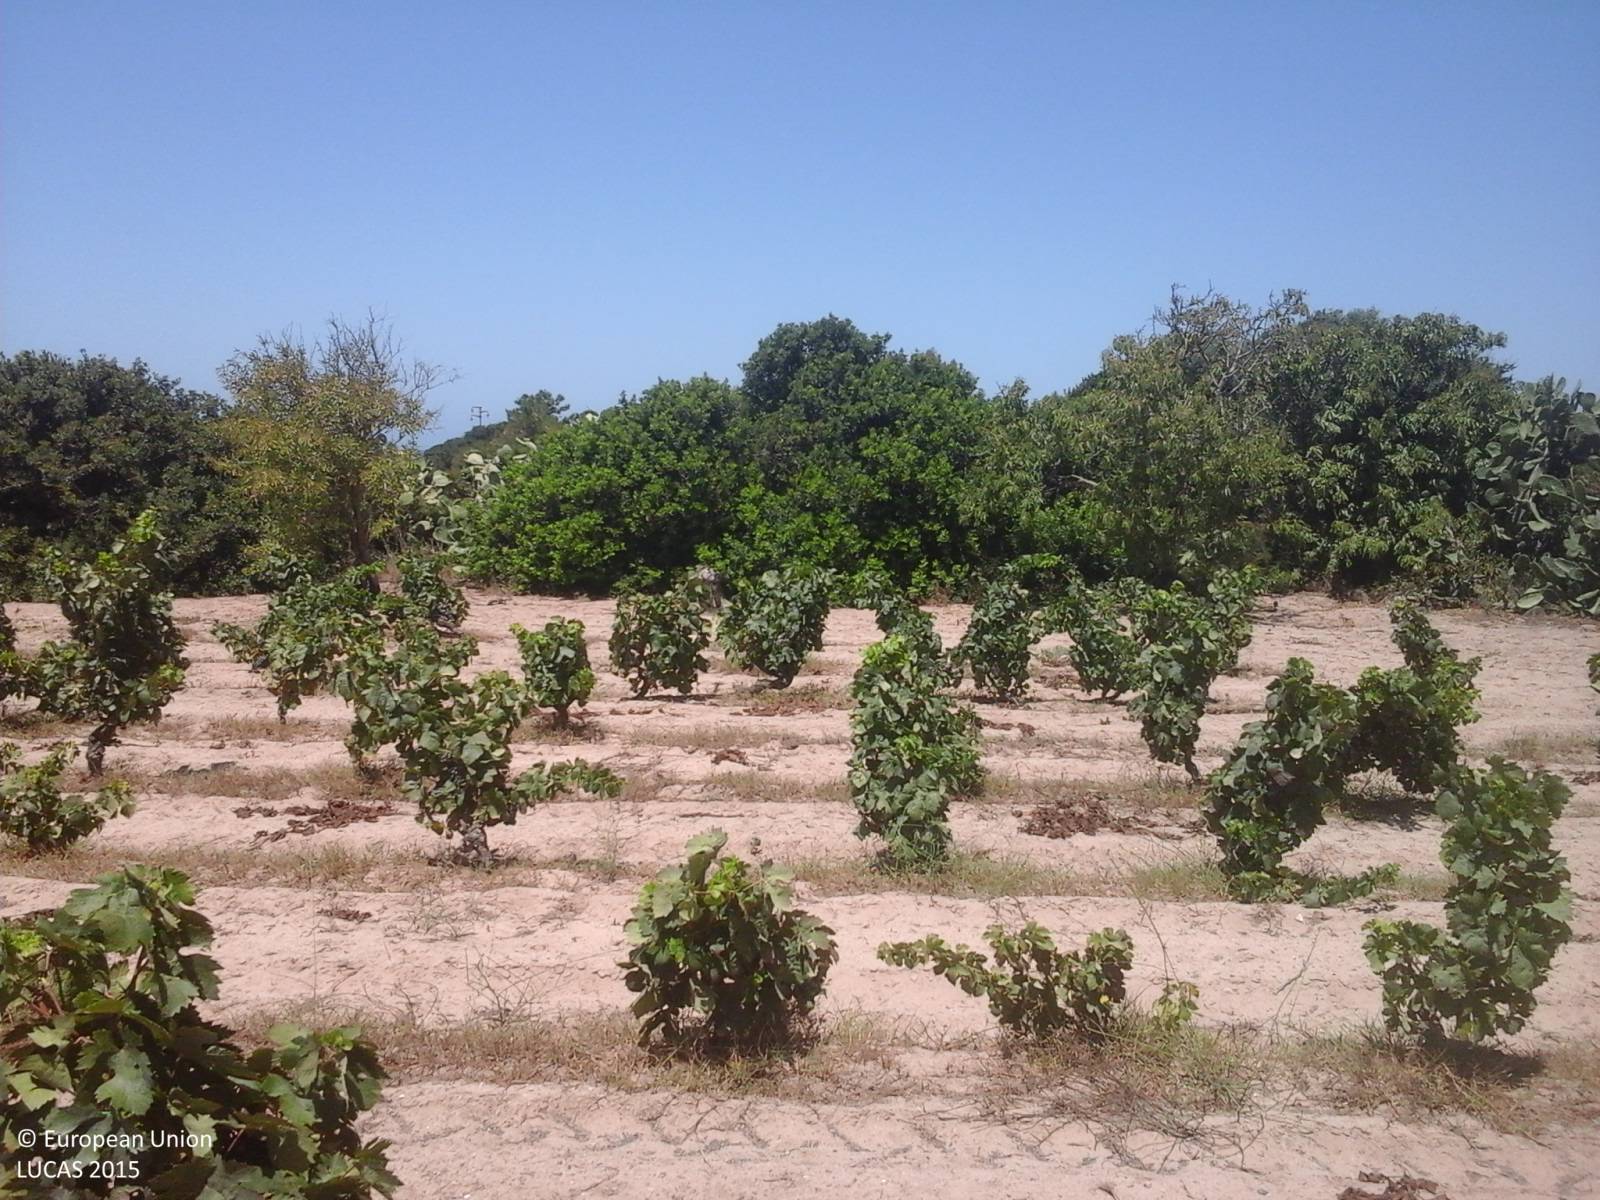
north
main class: Cropland
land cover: Vineyards
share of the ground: 50 - 75 %
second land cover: Other bare soil
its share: > 75 %
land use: Agriculture (excluding fallow land and kitchen gardens)
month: July
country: IT
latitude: 39.0949
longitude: 8.4029
